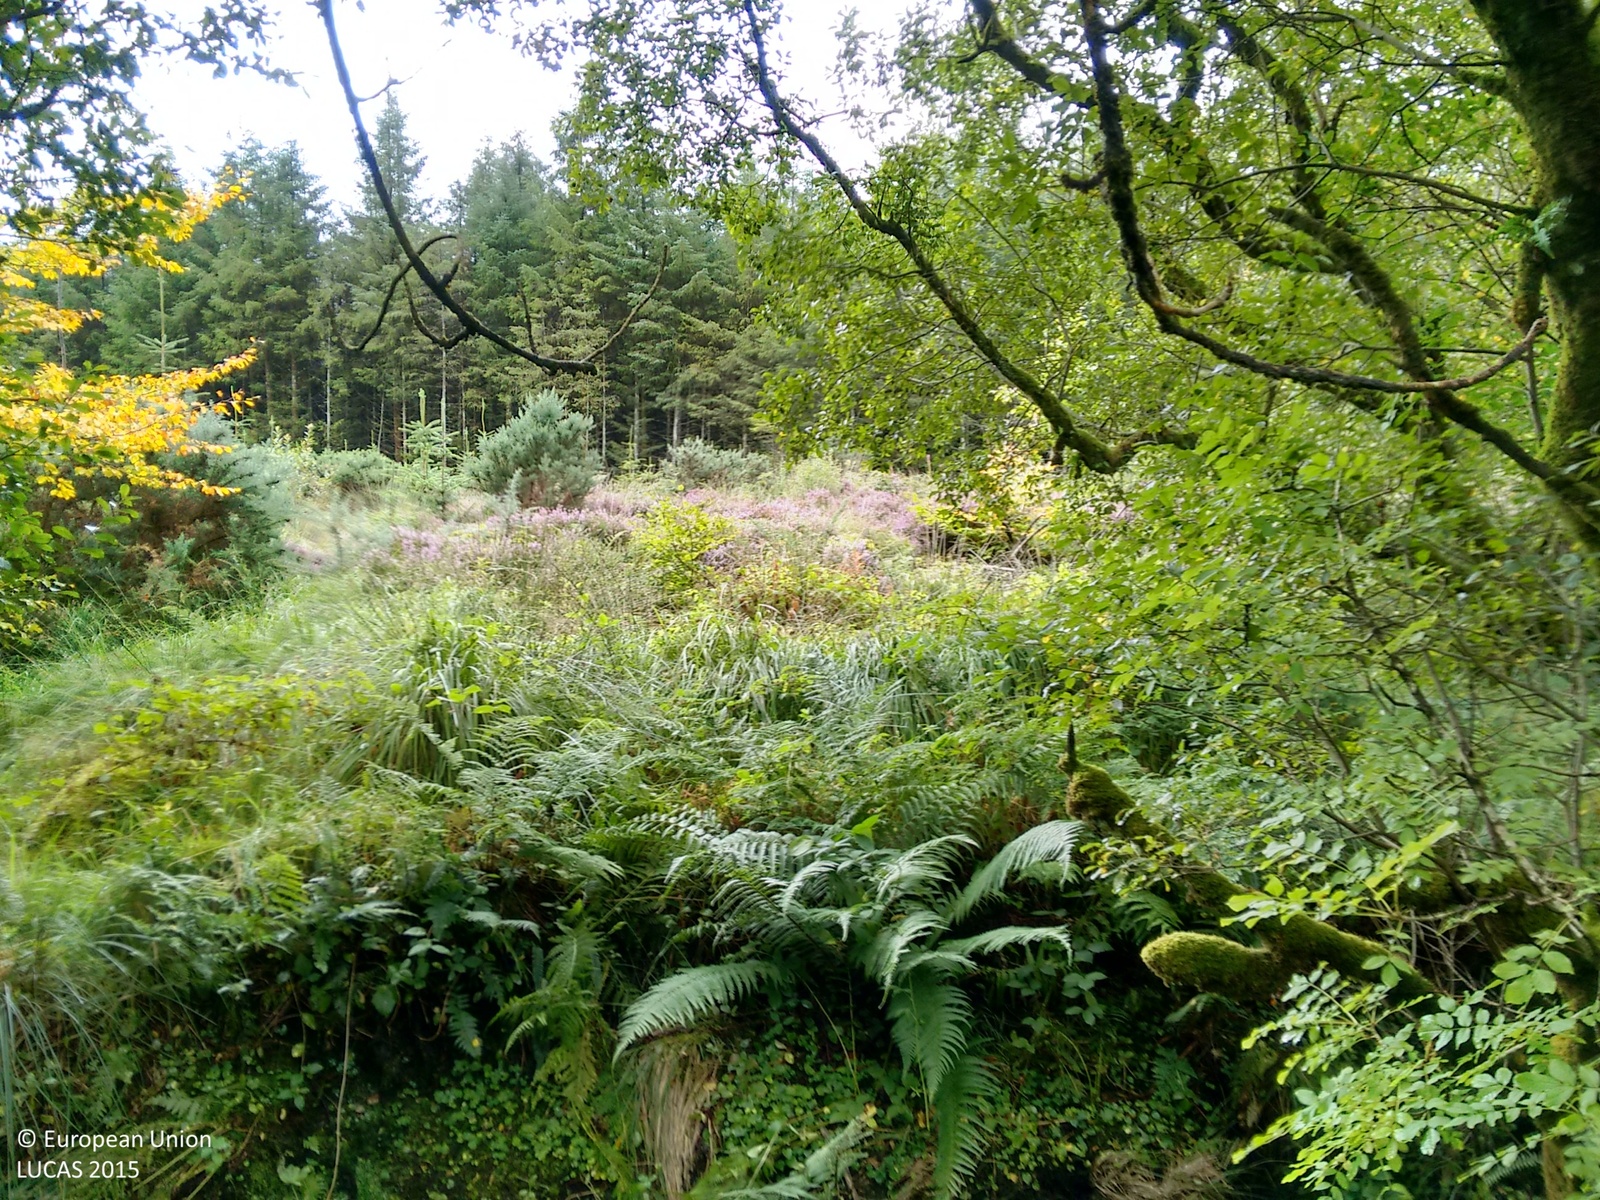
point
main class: Shrubland
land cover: Shrubland with sparse tree cover
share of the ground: > 75 %
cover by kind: shrubs 80 %, herbaceous plants 15 %, coniferous forest trees 5 %
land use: Forestry
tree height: < 5 m
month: September
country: IE
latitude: 52.9288
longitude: -8.7848
